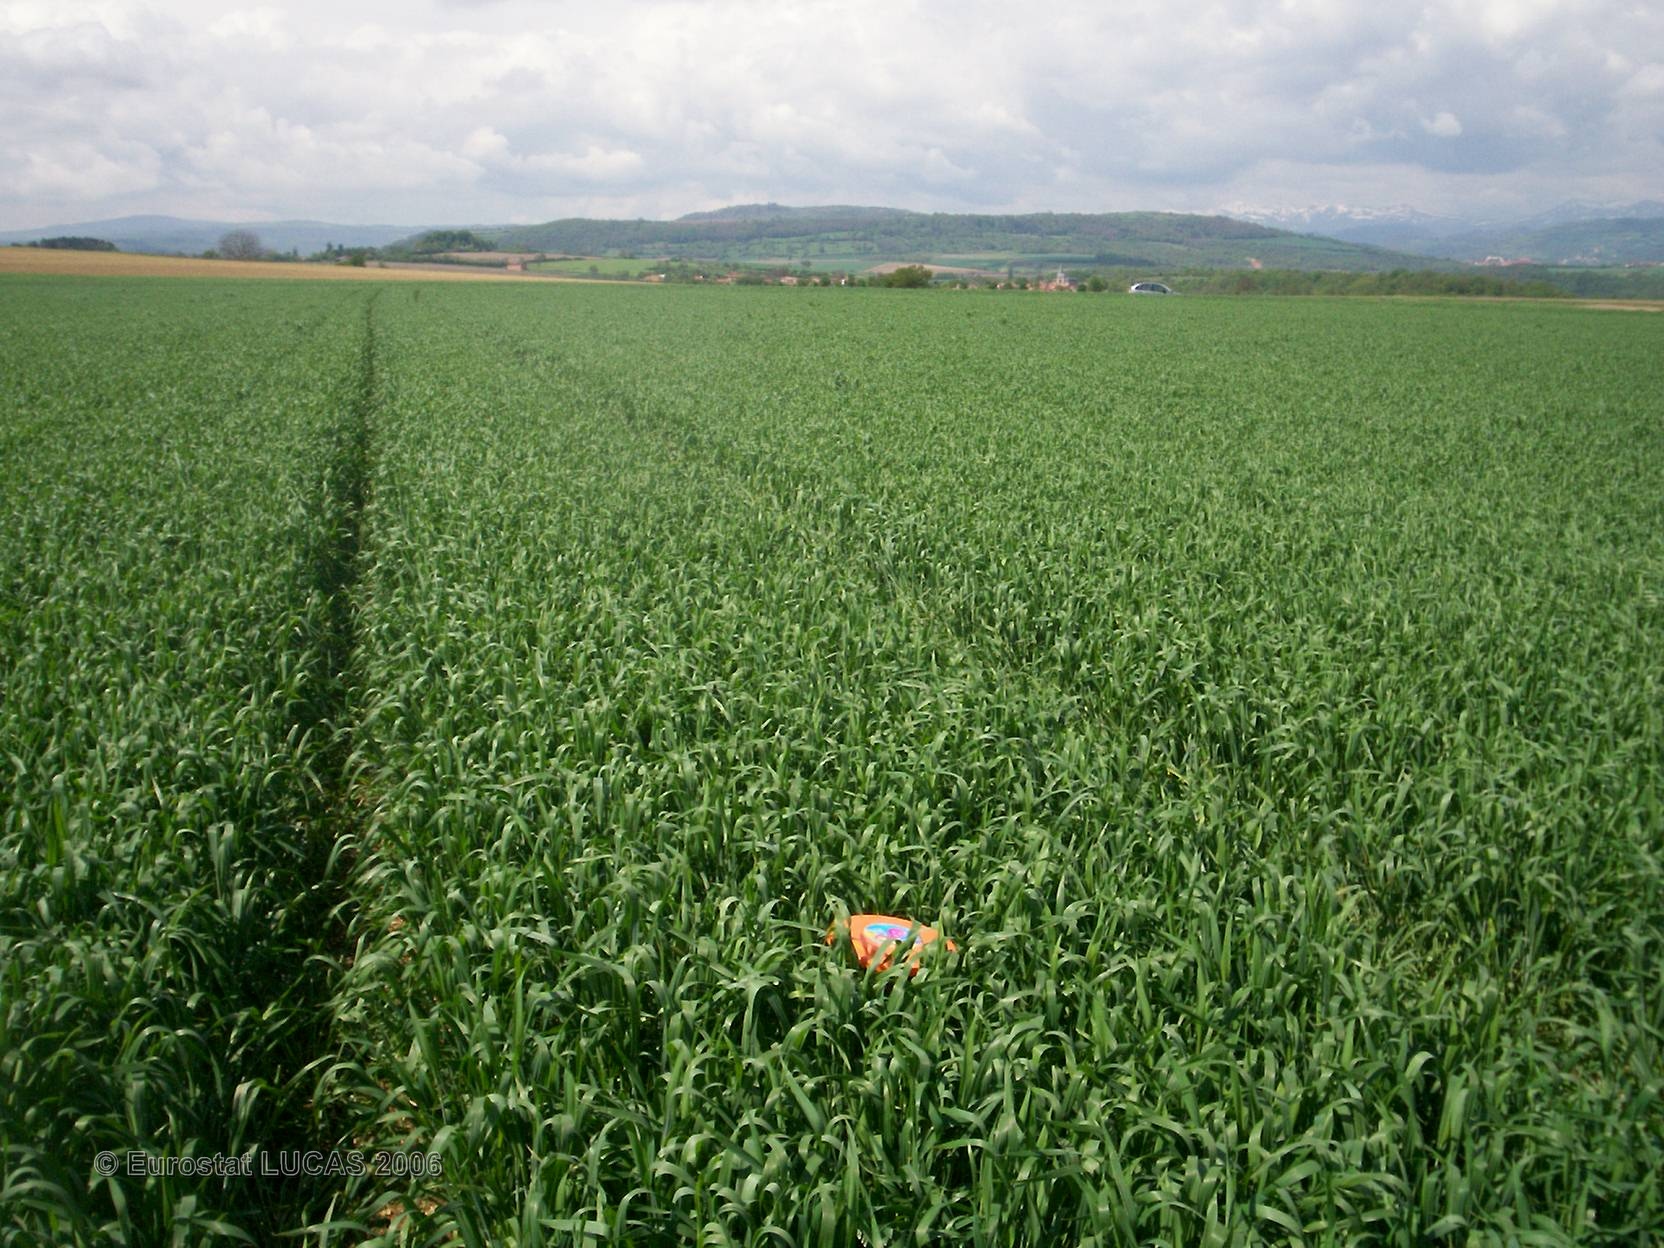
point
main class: Cropland
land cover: Common wheat
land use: Agriculture (excluding fallow land and kitchen gardens)
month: May
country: FR
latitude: 45.5921
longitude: 3.1940
